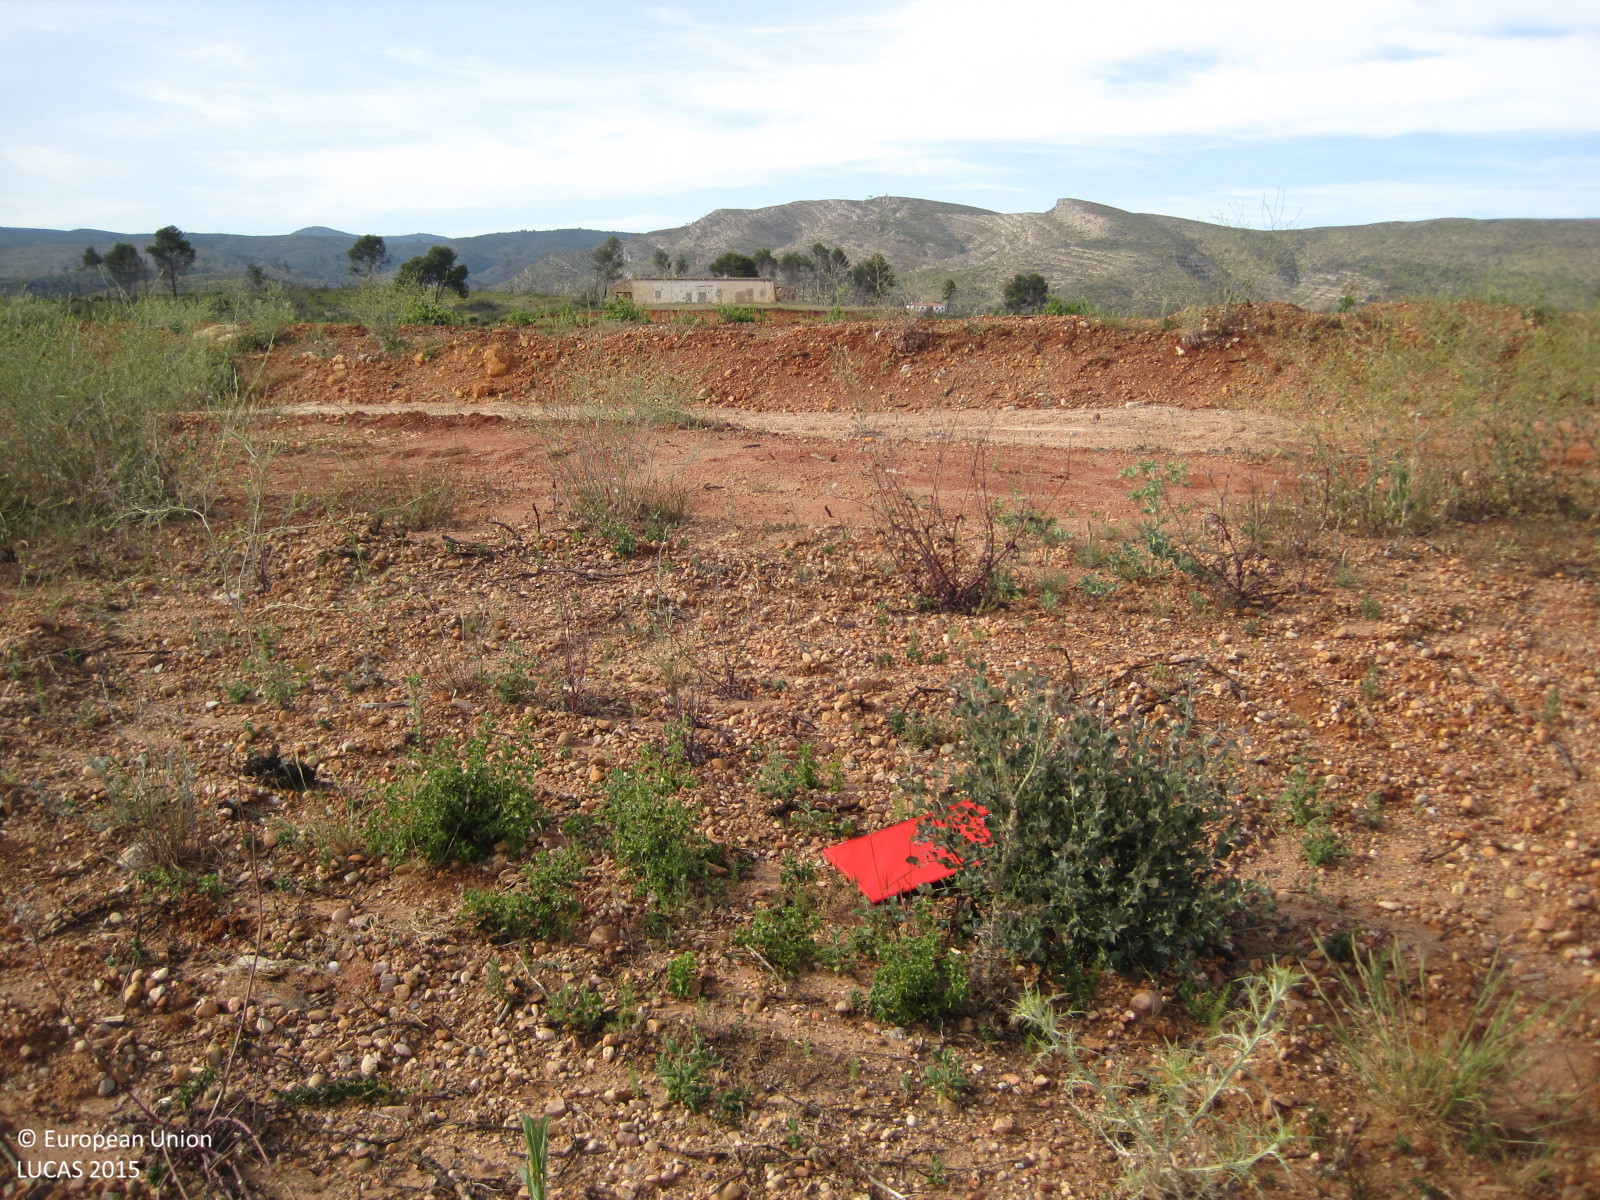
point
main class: Grassland
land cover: Spontaneously vegetated surfaces
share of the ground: 10 - 25 %
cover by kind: unconsolidated bare surface 85 %, herbaceous plants 15 %
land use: Abandoned areas
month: May
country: ES
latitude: 39.3332
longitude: -0.8686
